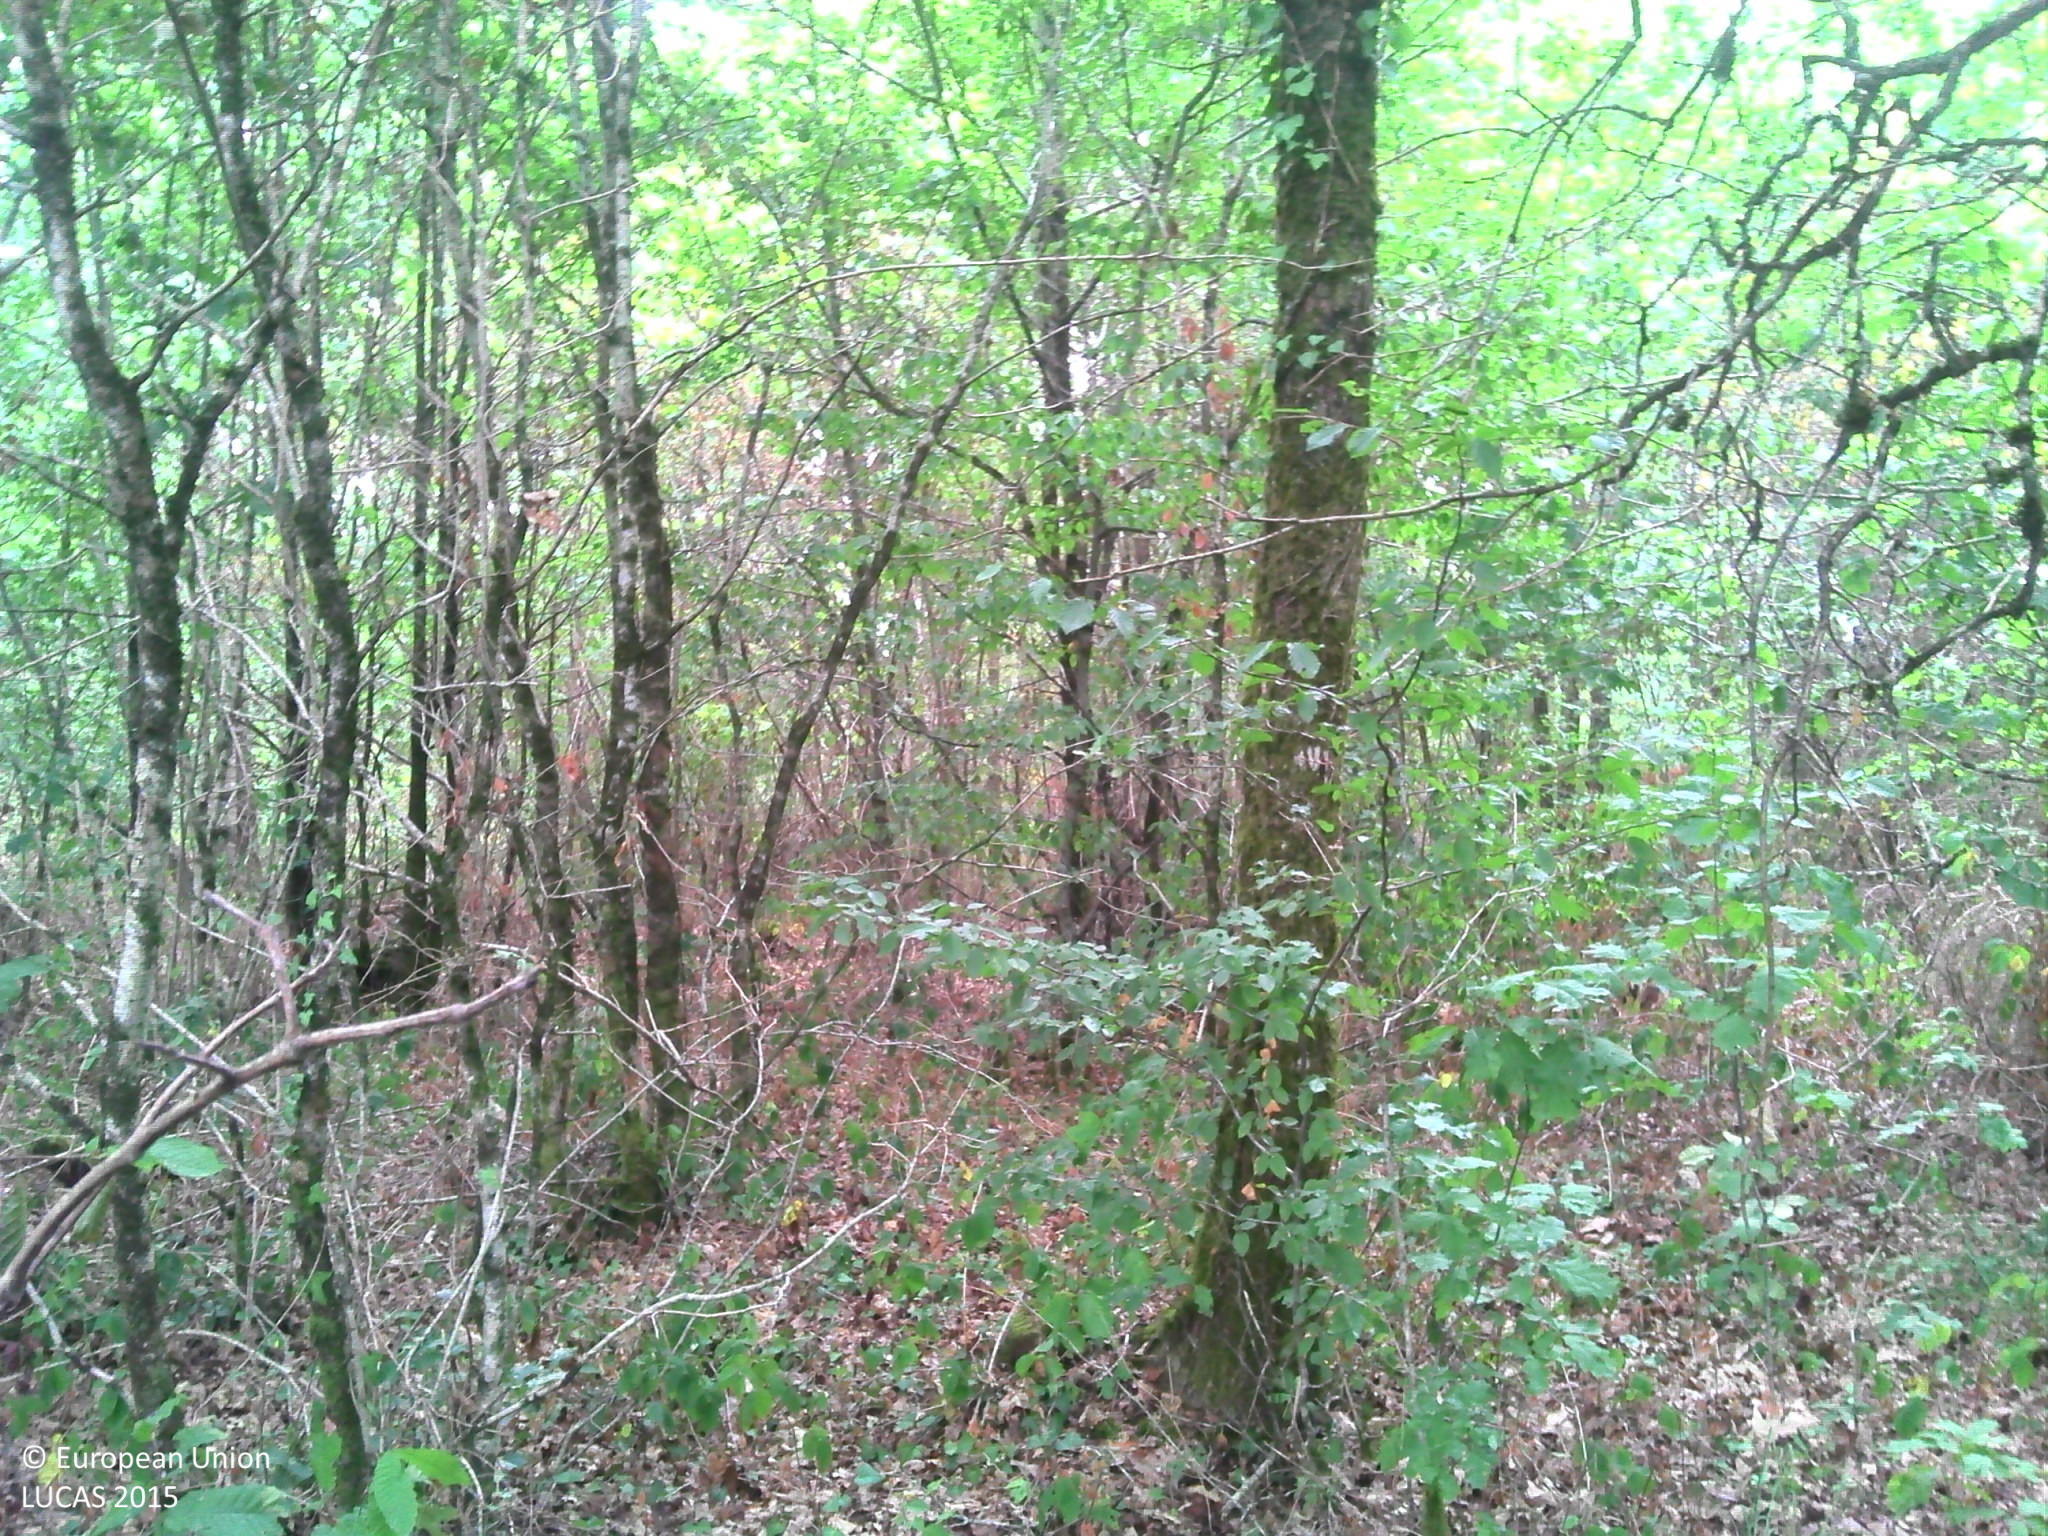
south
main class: Woodland
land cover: Broadleaved woodland
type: acidophilous oak and oak-birch forest
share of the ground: > 75 %
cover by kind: broadleaved forest trees 60 %, herbaceous plants 20 %, lichens and mosses 10 %, coniferous forest trees 5 %, shrubs 5 %
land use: Forestry
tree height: > 5 m
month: July
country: FR
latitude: 45.3126
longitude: 1.3582
